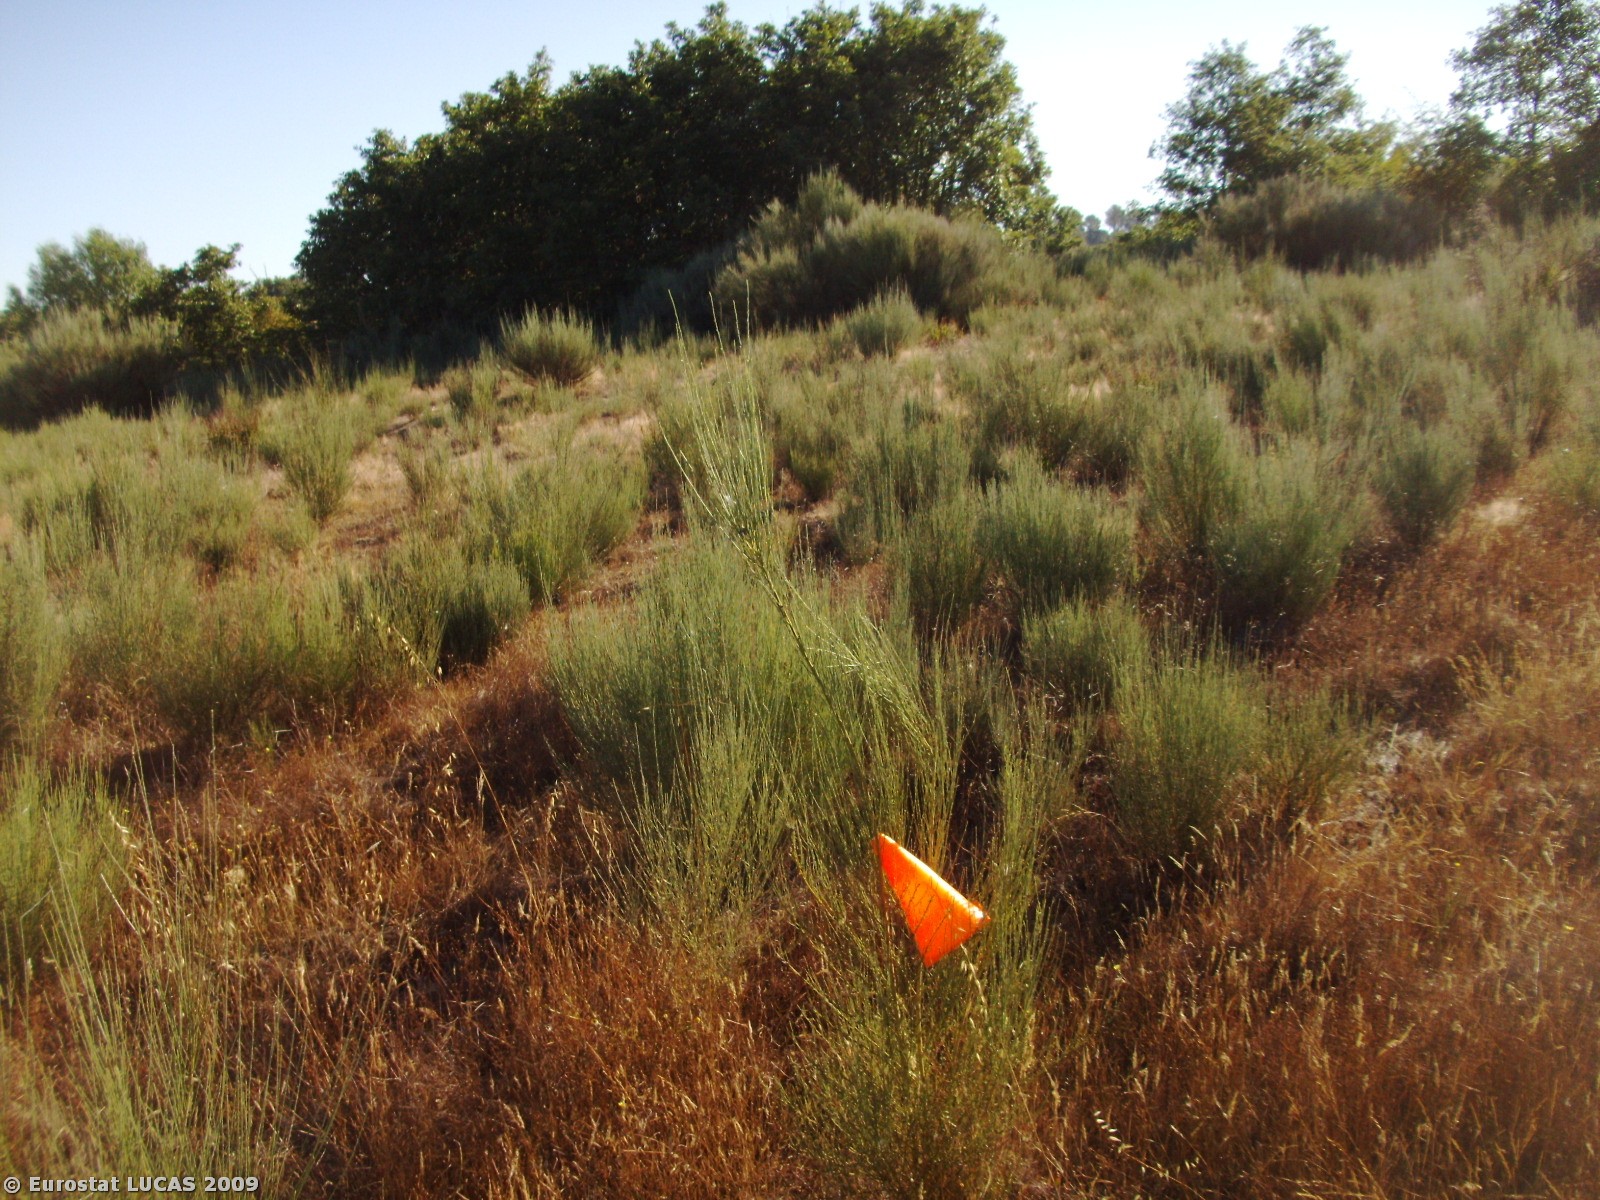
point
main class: Shrubland
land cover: Shrubland with sparse tree cover
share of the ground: > 75 %
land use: Fallow land
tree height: > 5 m
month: July
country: PT
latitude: 40.3064
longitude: -7.3892
